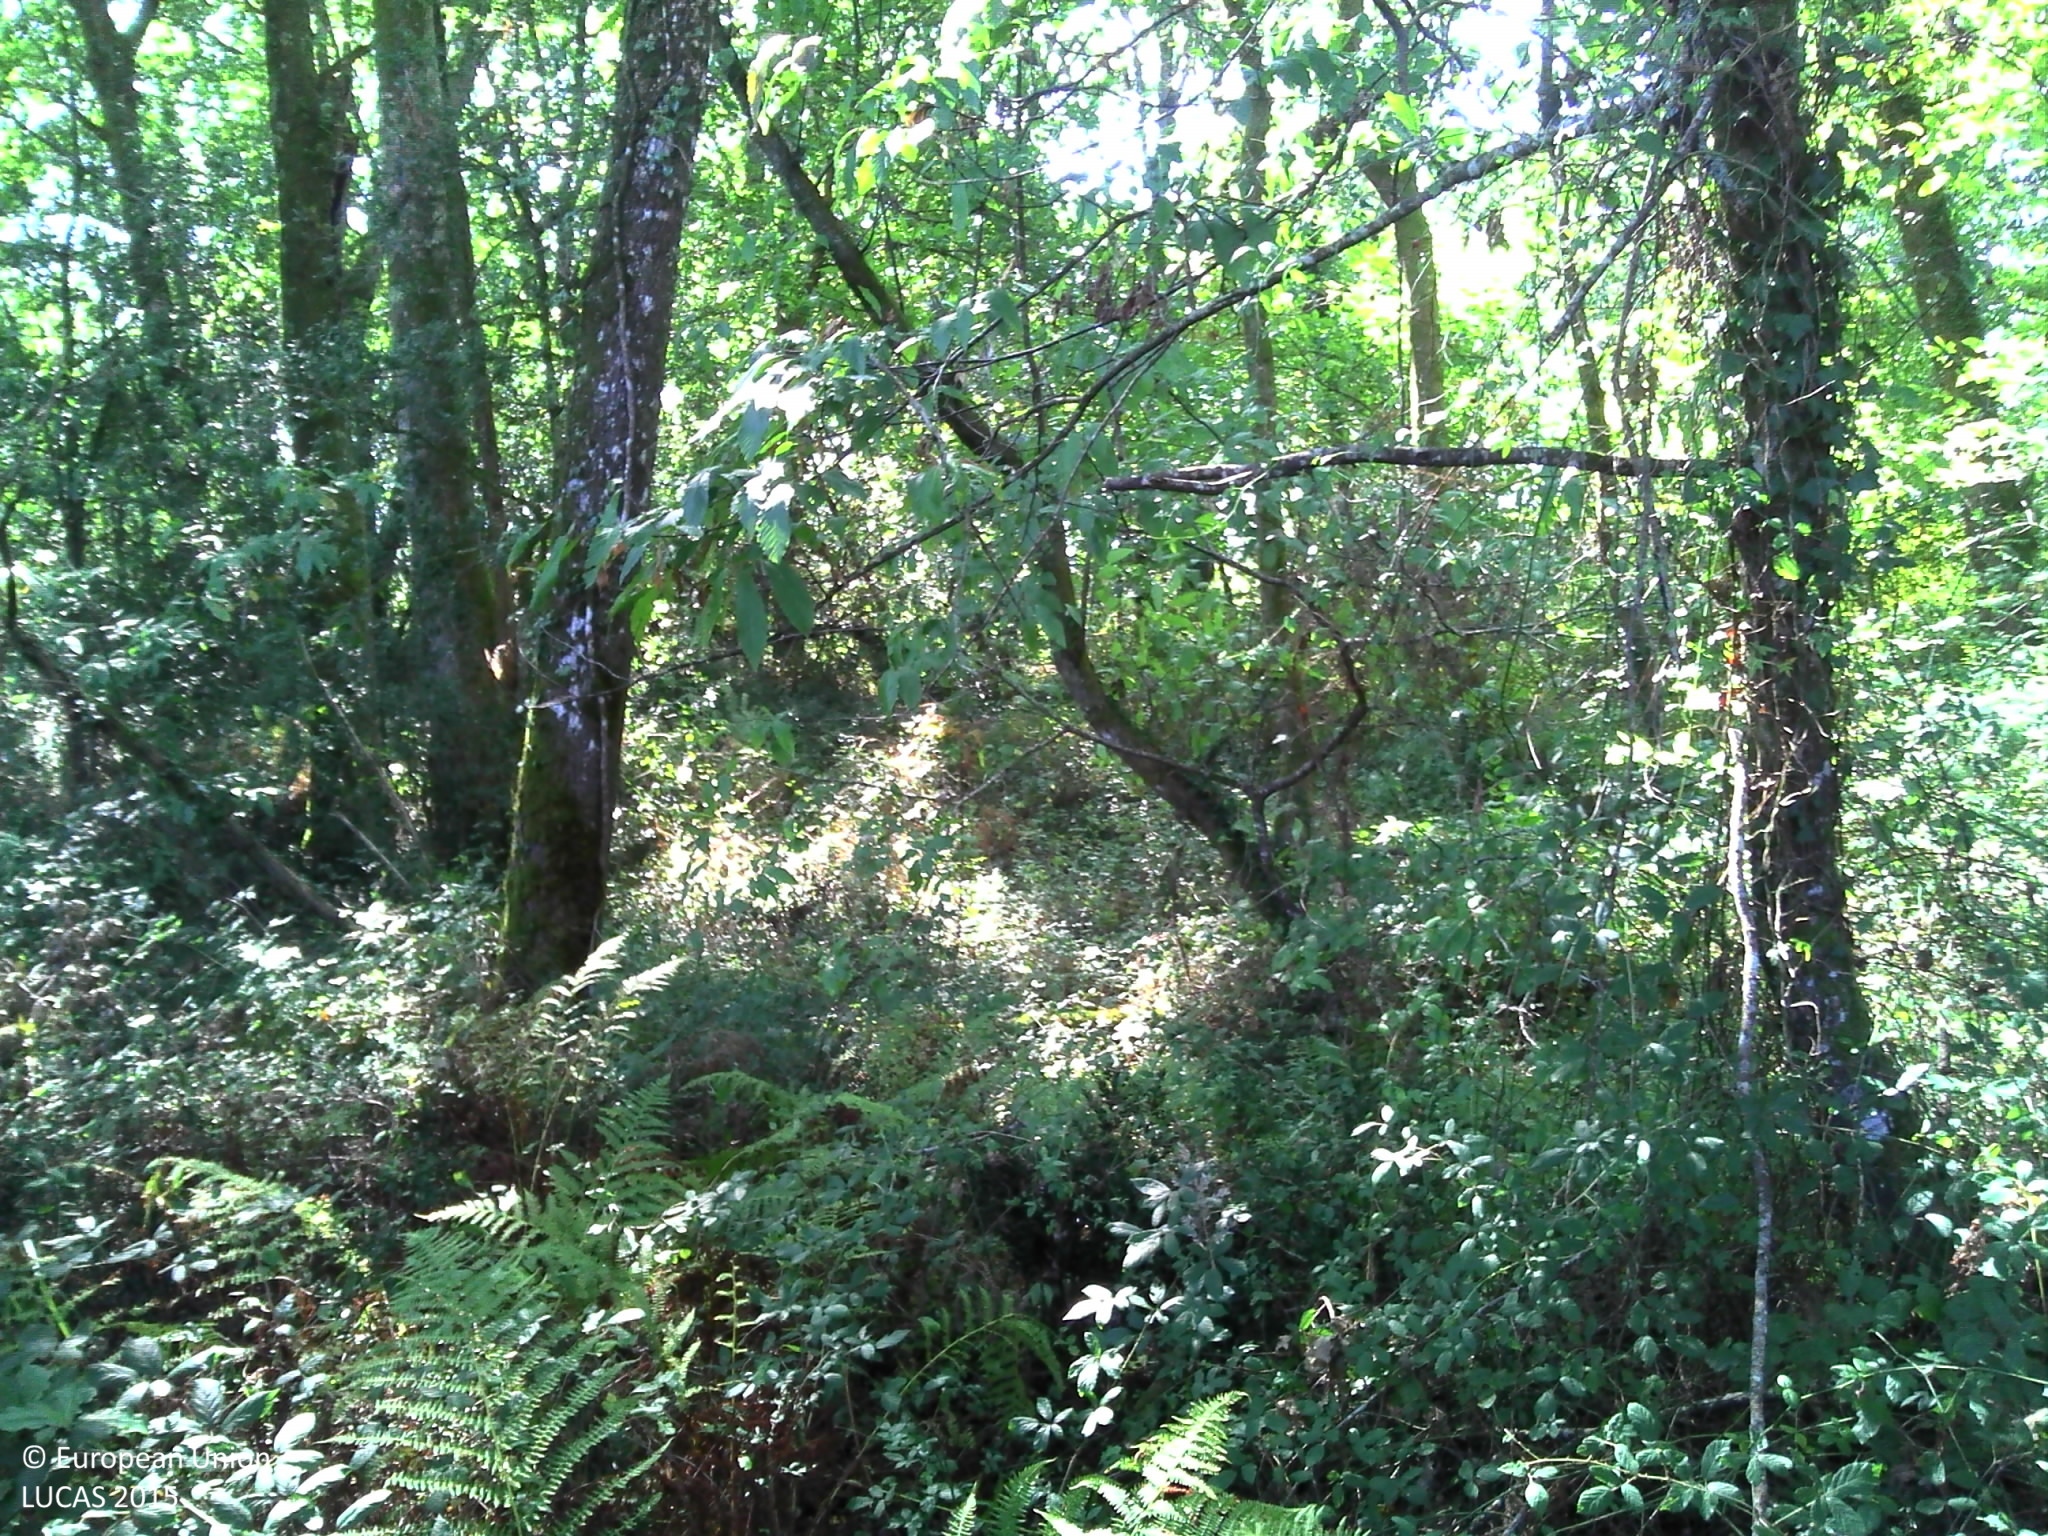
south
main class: Woodland
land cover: Broadleaved woodland
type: acidophilous oak and oak-birch forest
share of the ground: > 75 %
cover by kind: broadleaved forest trees 75 %, shrubs 15 %, herbaceous plants 5 %, lichens and mosses 5 %
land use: Forestry
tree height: > 5 m
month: September
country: FR
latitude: 43.2871
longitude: -0.6945
